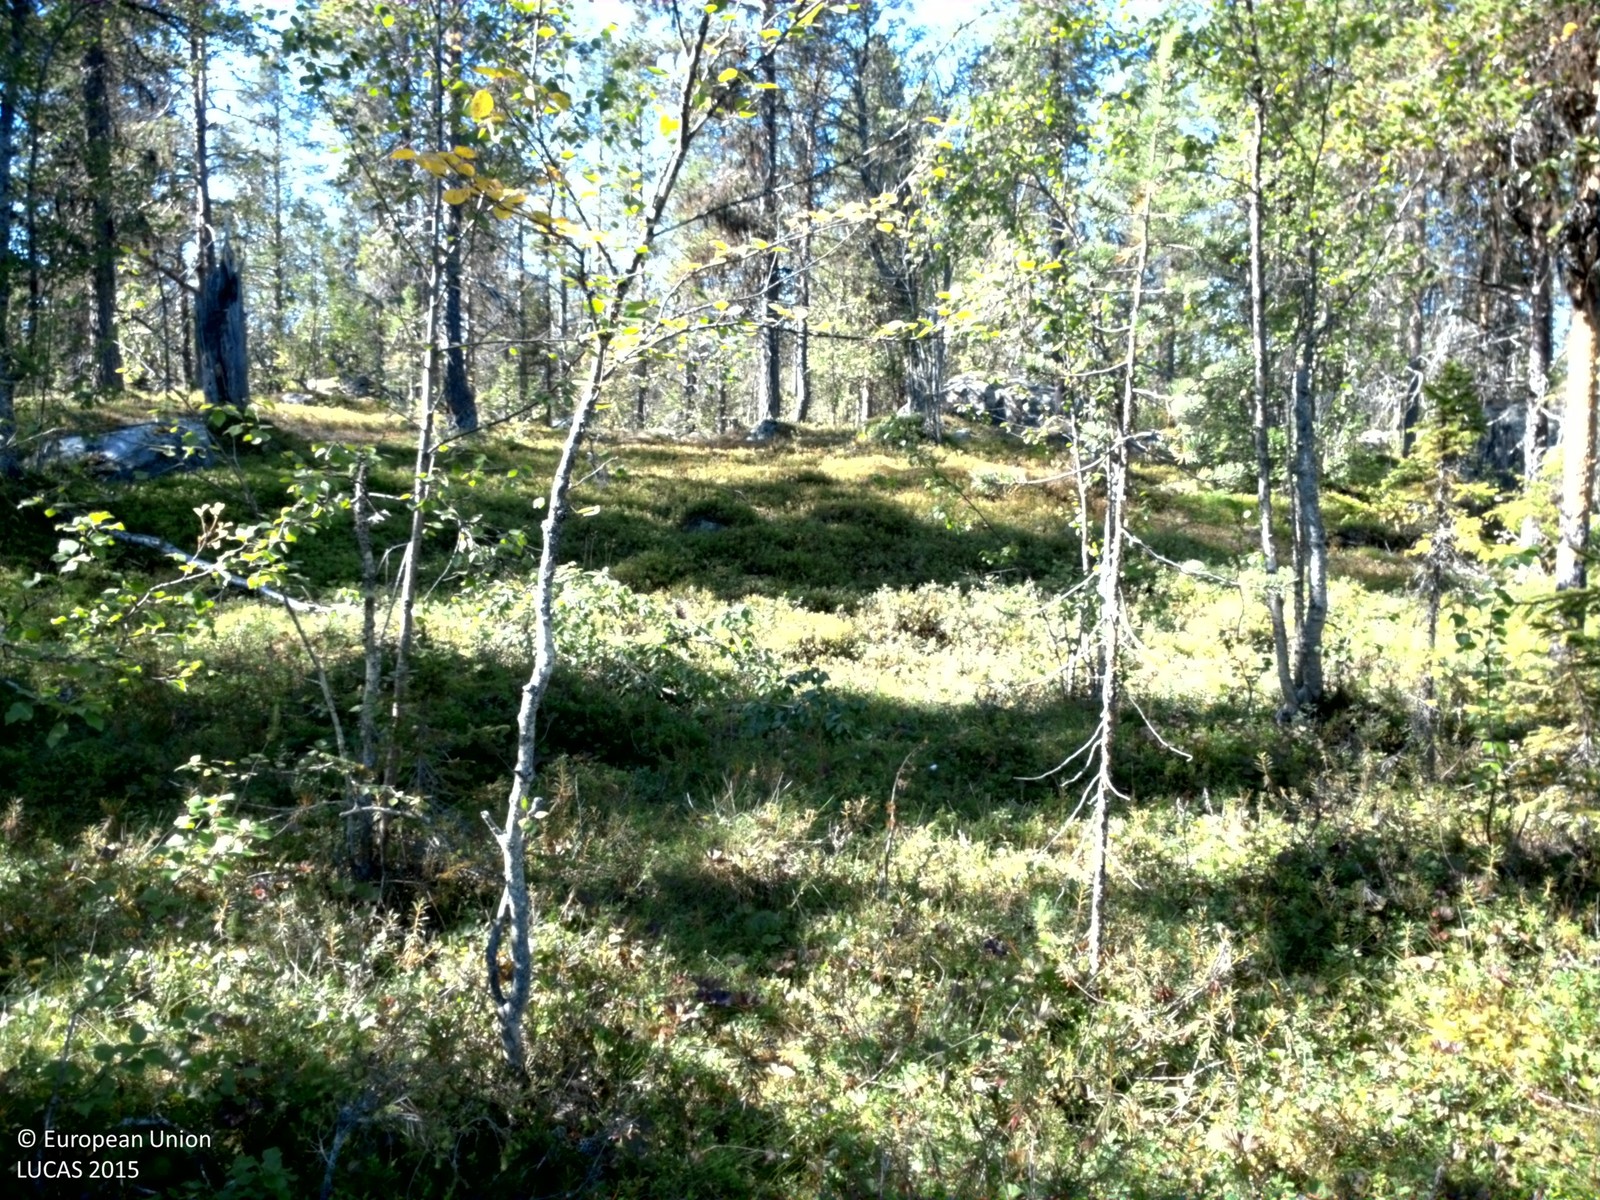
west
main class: Woodland
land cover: Pine dominated coniferous woodland
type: boreal forest
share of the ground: 25 - 50 %
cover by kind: shrubs 70 %, coniferous forest trees 25 %, broadleaved forest trees 5 %
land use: Forestry
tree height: > 5 m
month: August
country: SE
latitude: 66.6287
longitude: 18.8282
